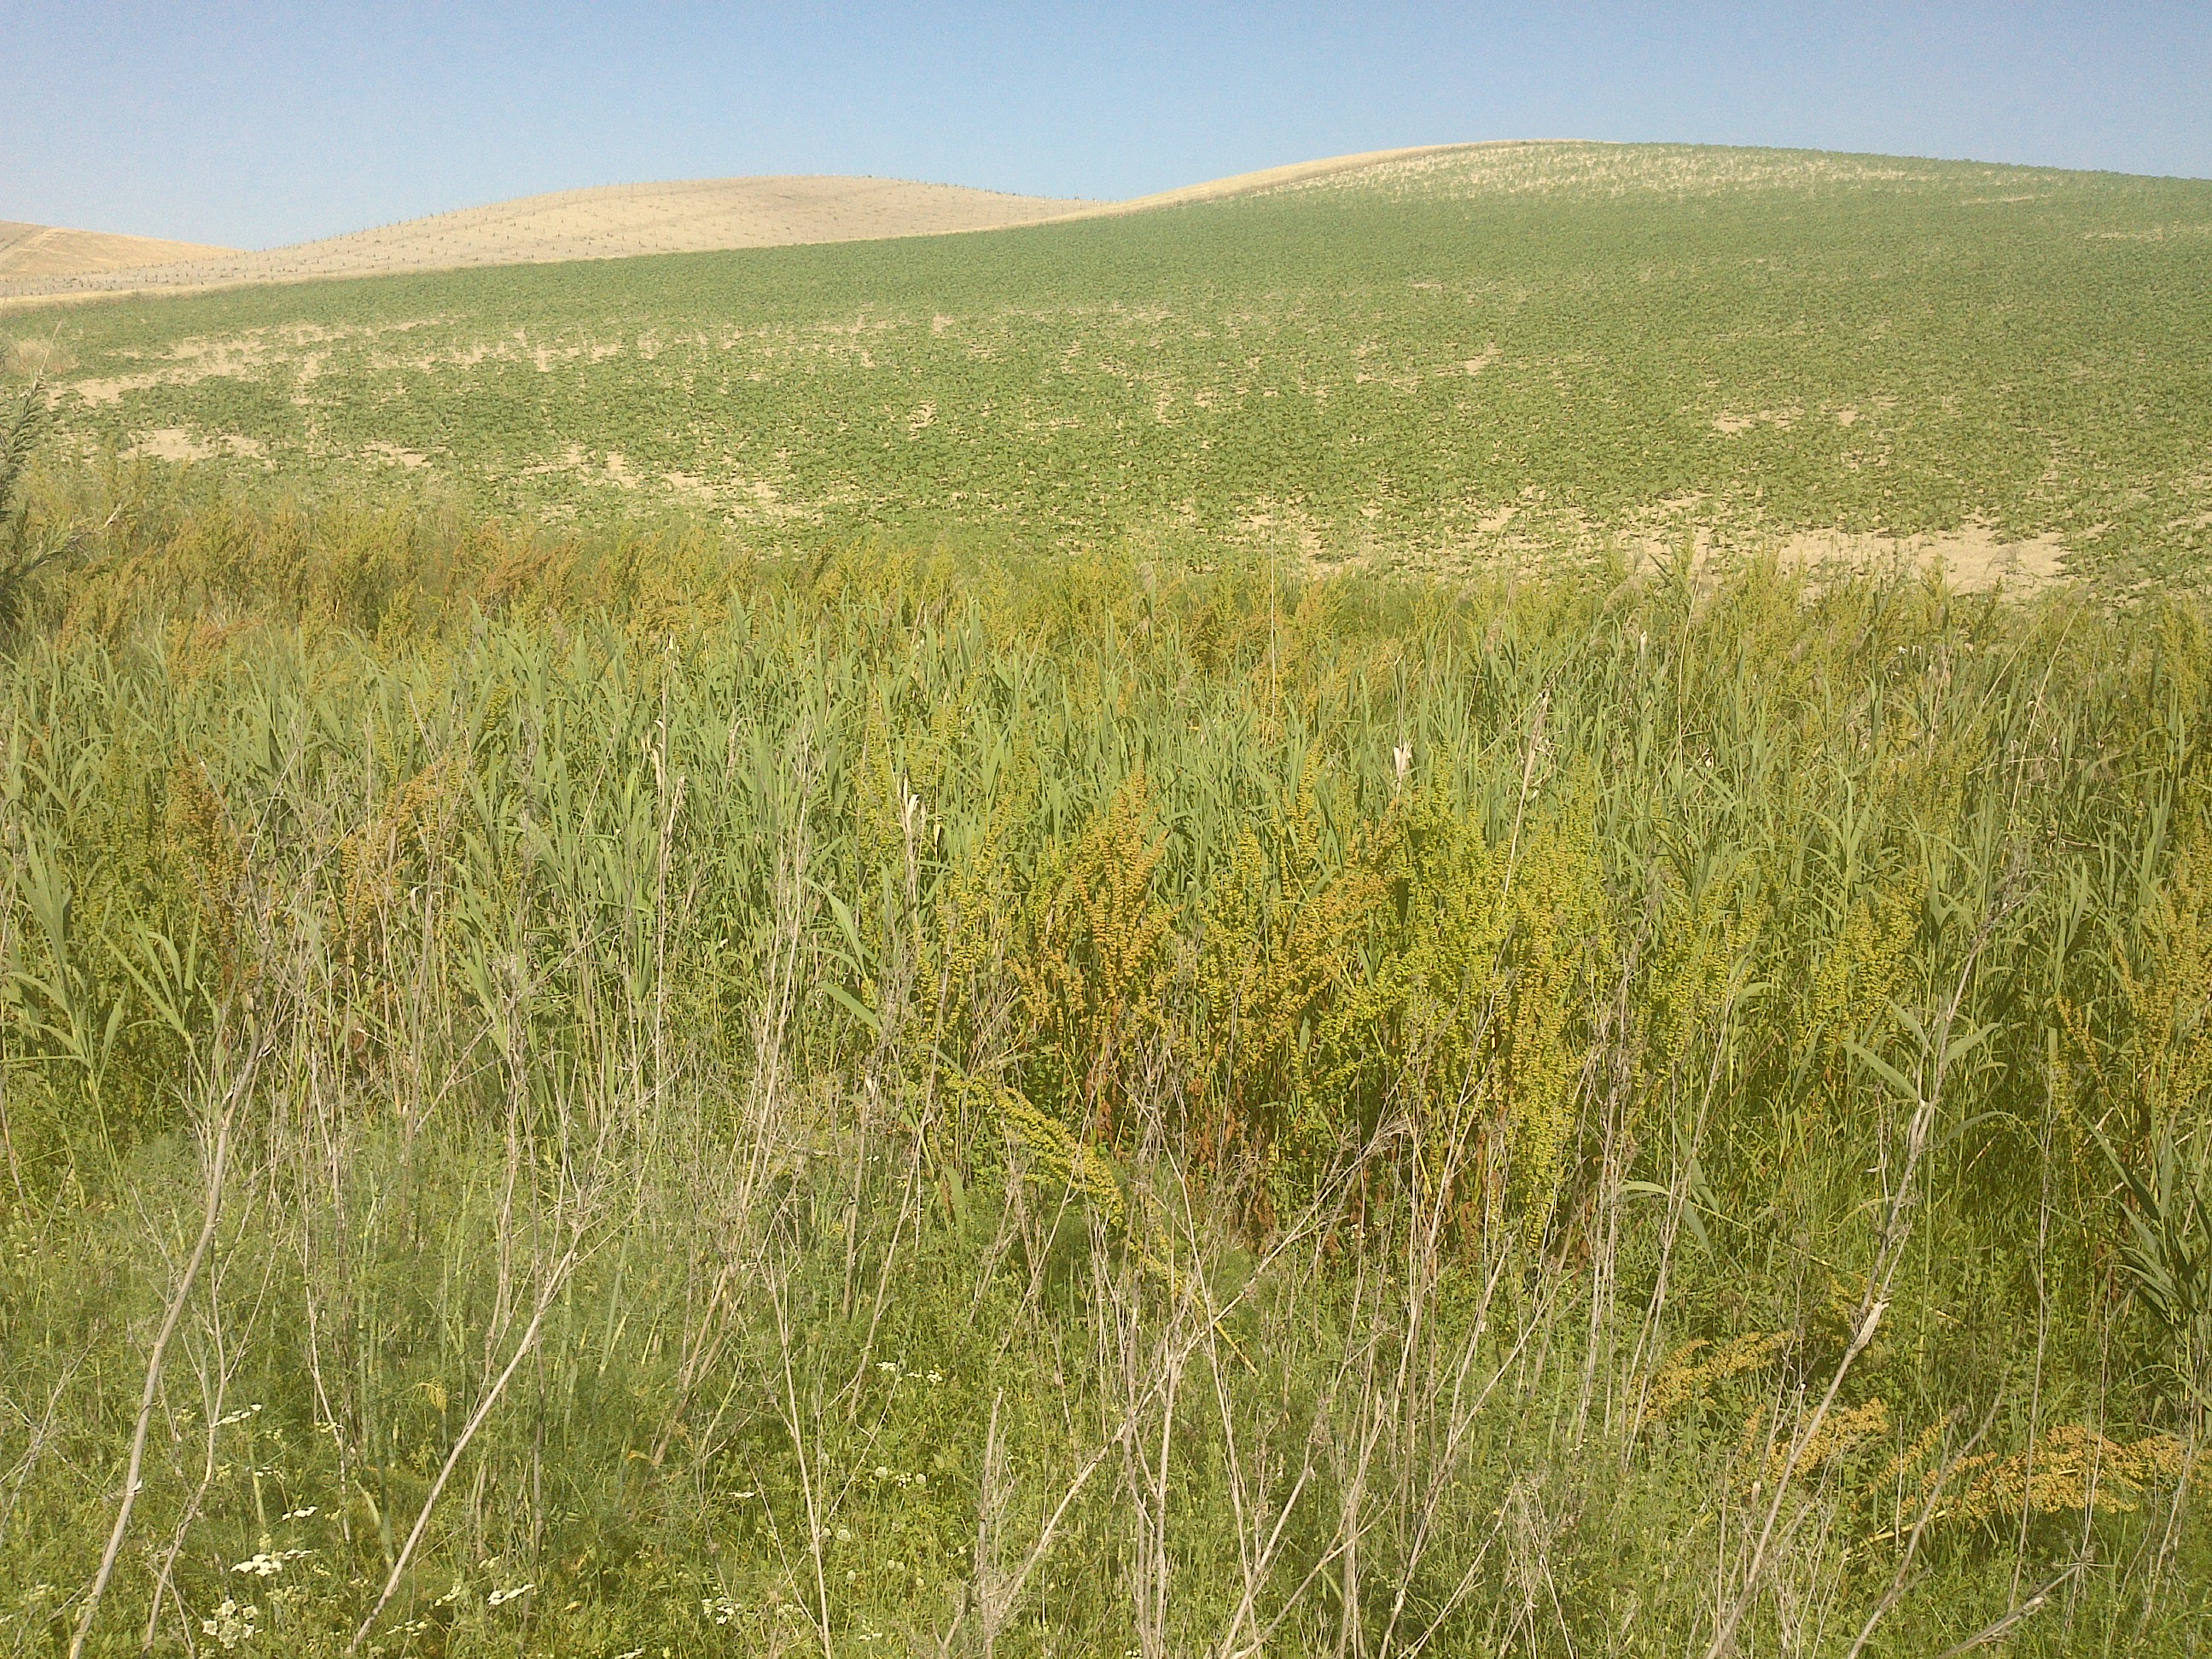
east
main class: Shrubland
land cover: Shrubland with sparse tree cover
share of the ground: 25 - 50 %
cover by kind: shrubs 65 %, herbaceous plants 30 %, broadleaved forest trees 5 %
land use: Semi-natural and natural areas not in use
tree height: < 5 m
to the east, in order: Shrubland with sparse tree cover; Sunflower; Durum wheat
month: May
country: ES
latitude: 37.7837
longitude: -4.6471
